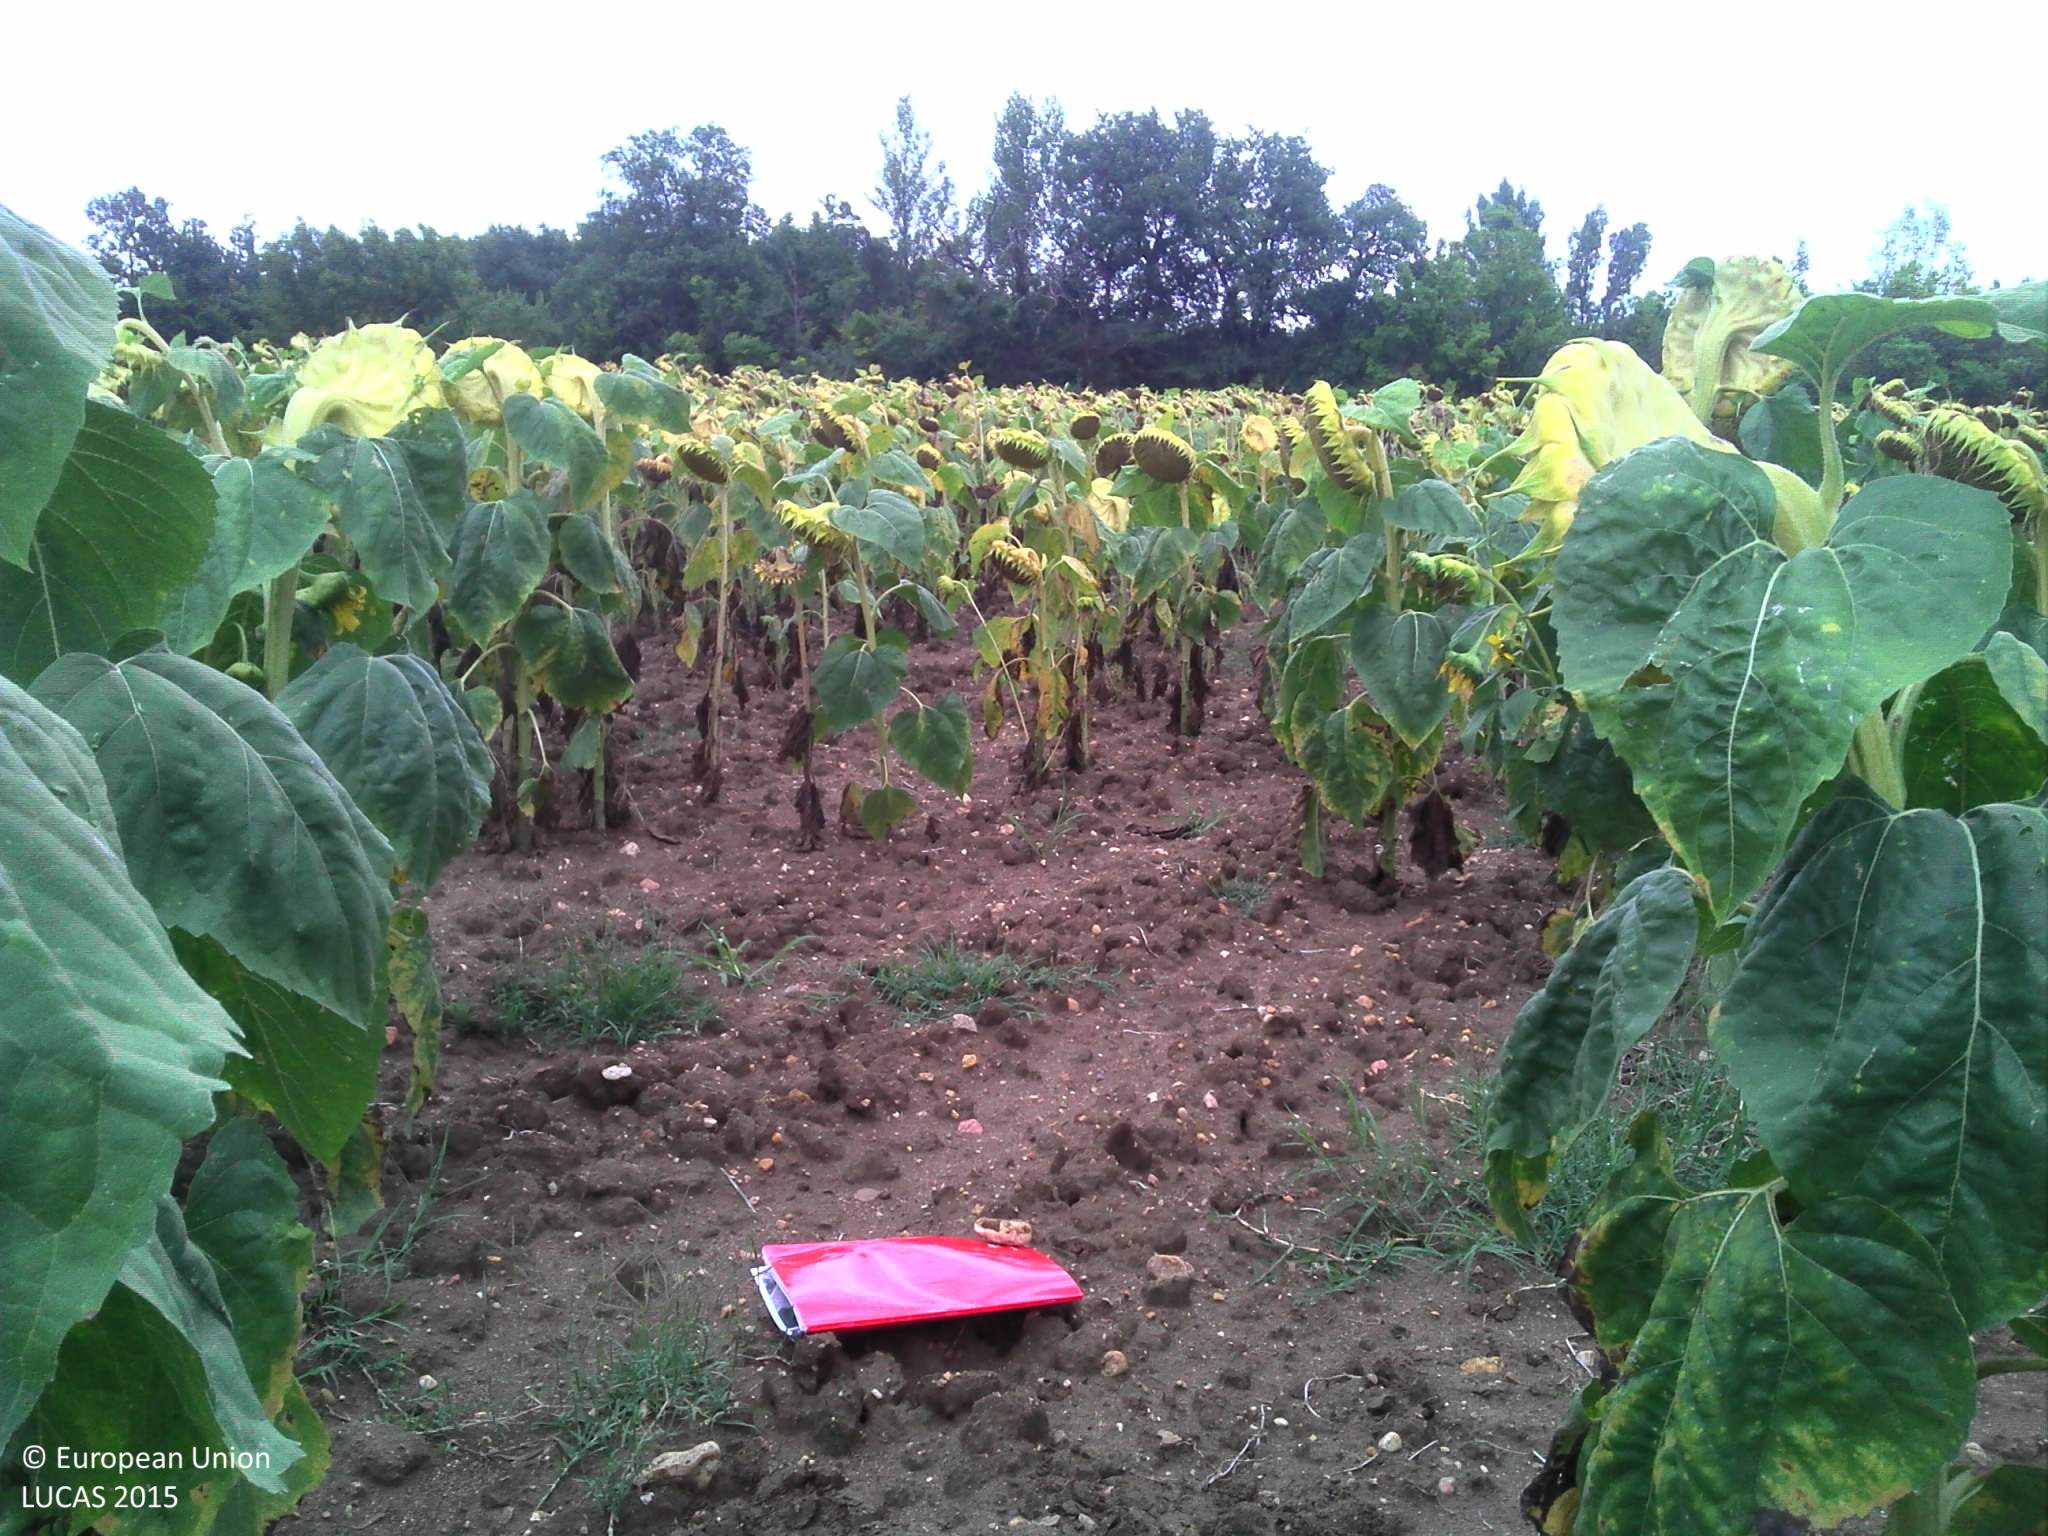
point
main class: Cropland
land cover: Sunflower
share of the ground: 50 - 75 %
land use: Agriculture (excluding fallow land and kitchen gardens)
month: June
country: FR
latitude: 43.3187
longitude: 2.0286
